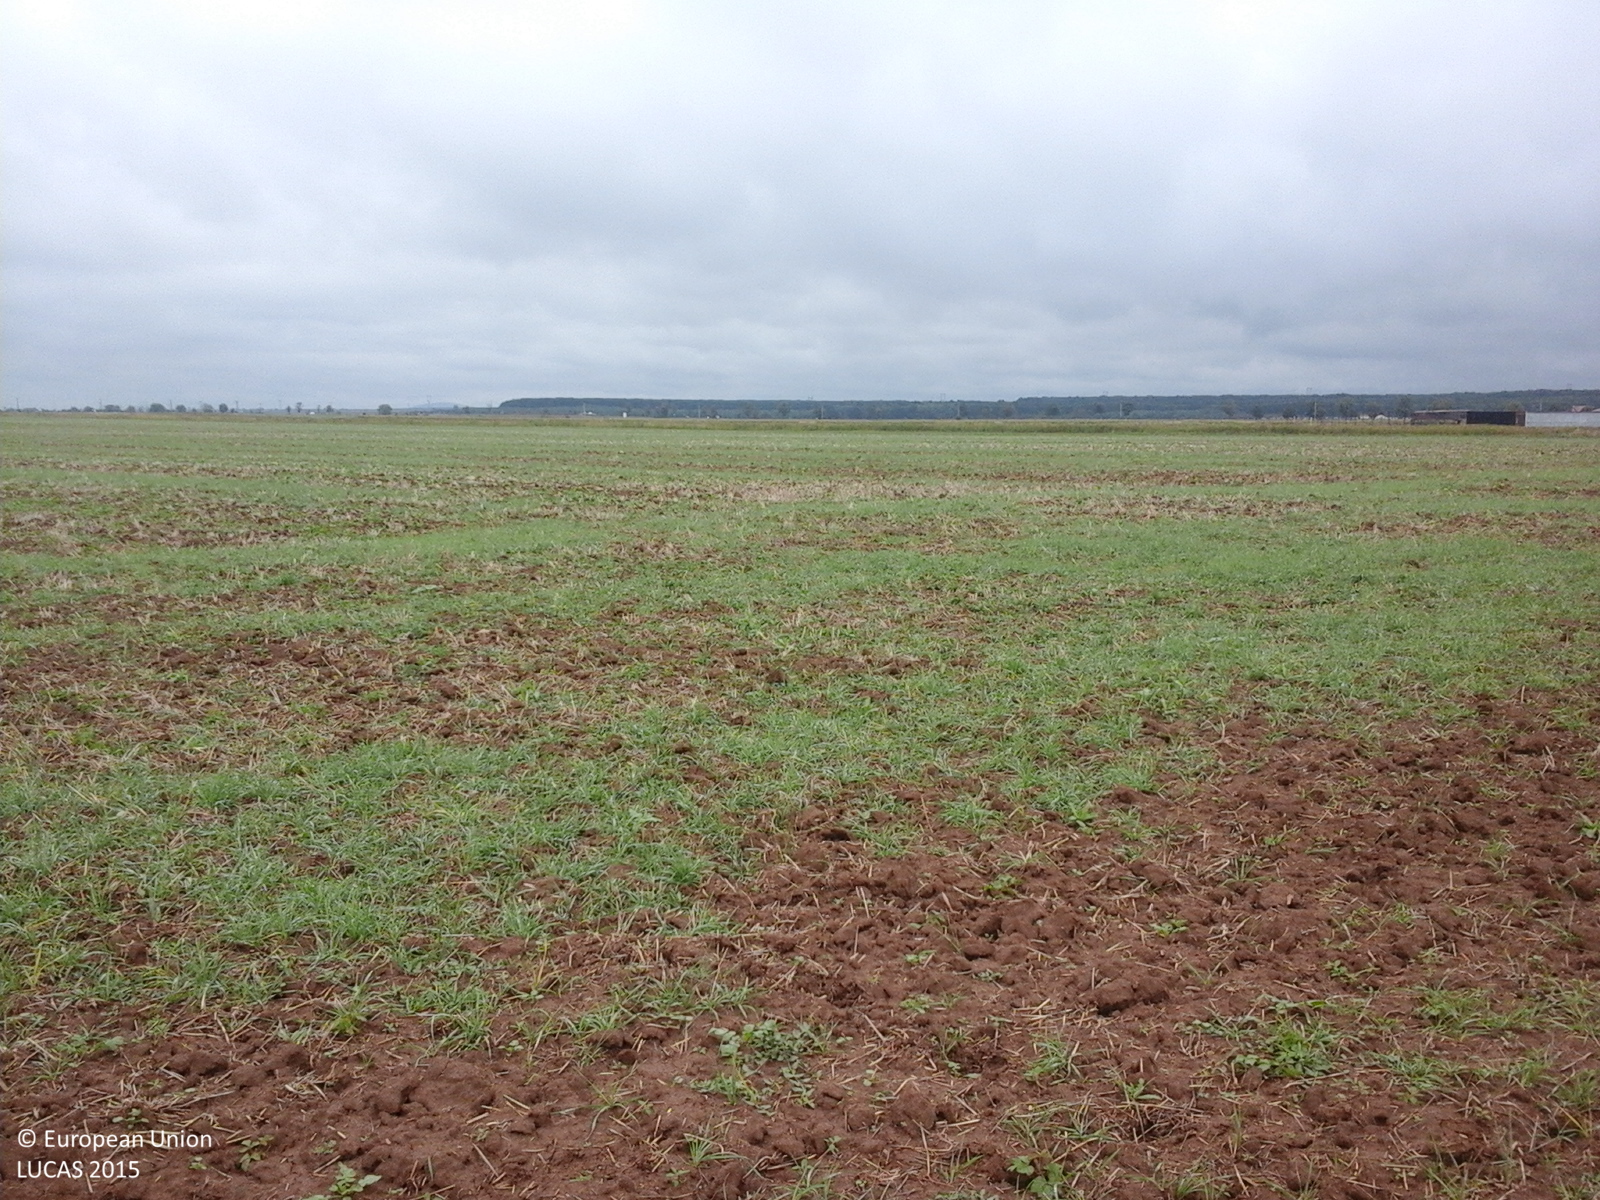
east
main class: Cropland
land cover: Durum wheat
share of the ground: 50 - 75 %
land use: Agriculture (excluding fallow land and kitchen gardens)
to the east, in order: Durum wheat; Spontaneously vegetated surfaces
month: September
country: RO
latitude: 46.9504
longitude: 21.8035
